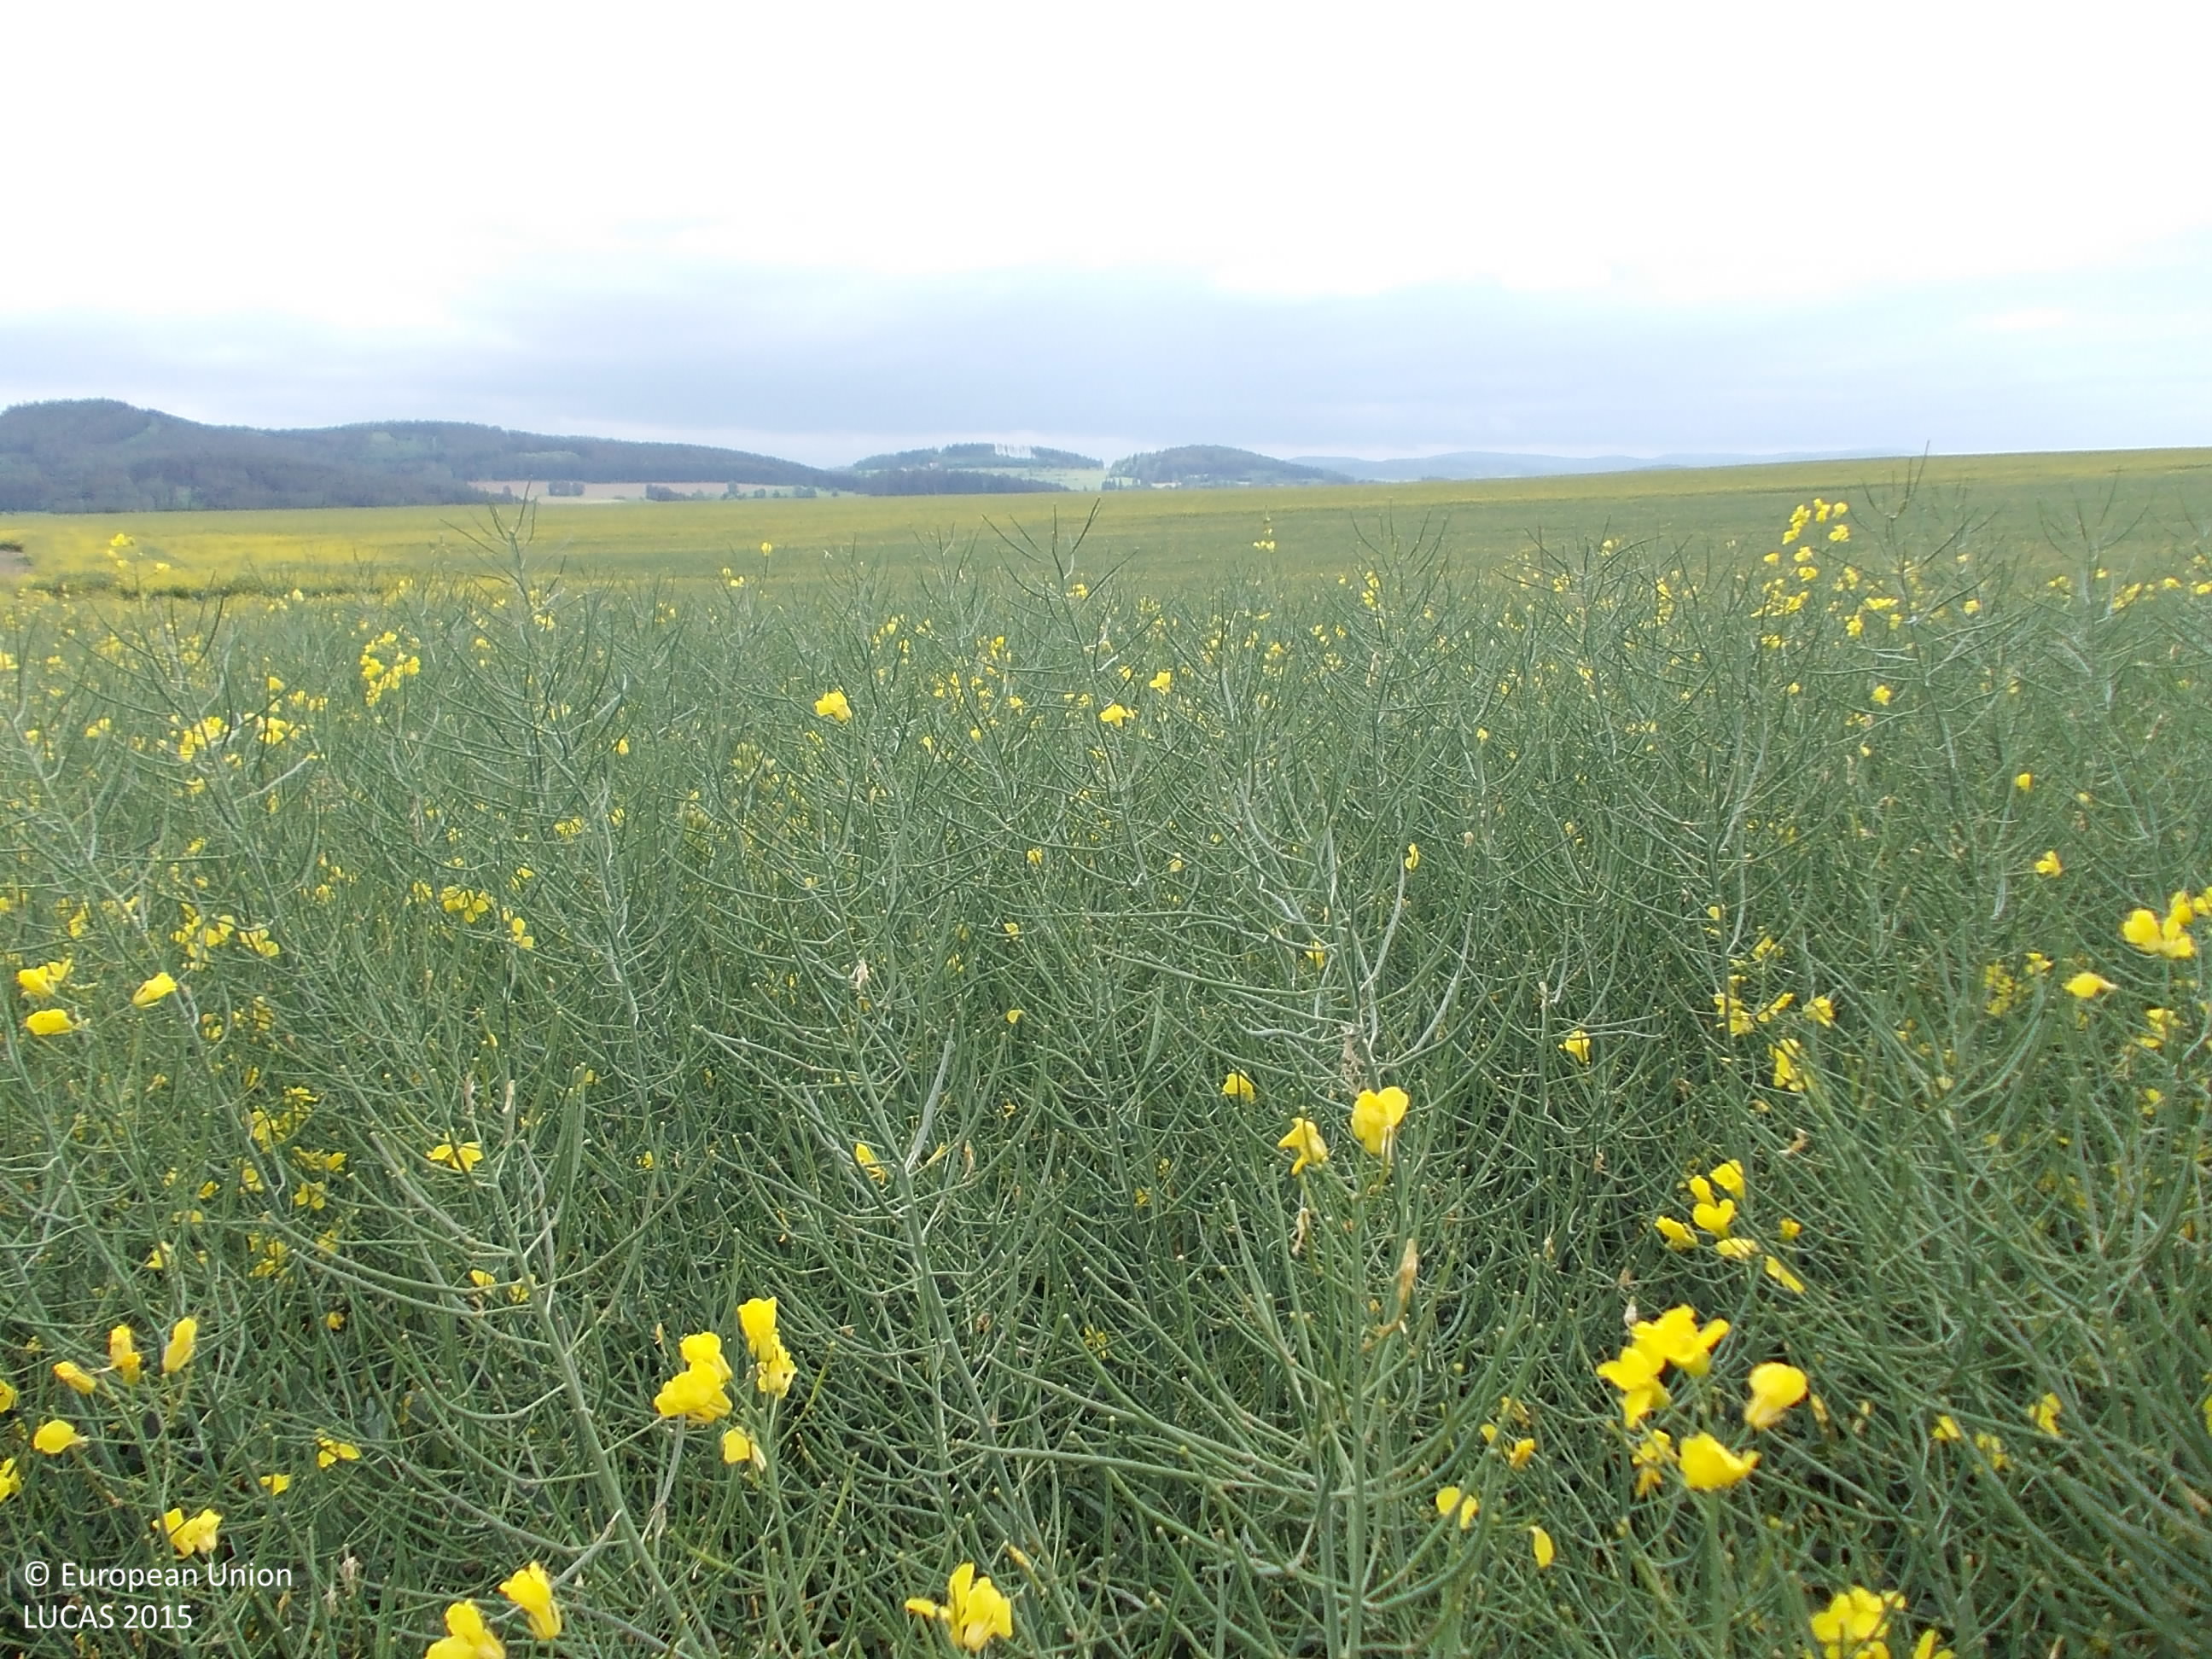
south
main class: Cropland
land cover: Rape and turnip rape
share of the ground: > 75 %
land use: Agriculture (excluding fallow land and kitchen gardens)
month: May
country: CZ
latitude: 49.2754
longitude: 13.7802
